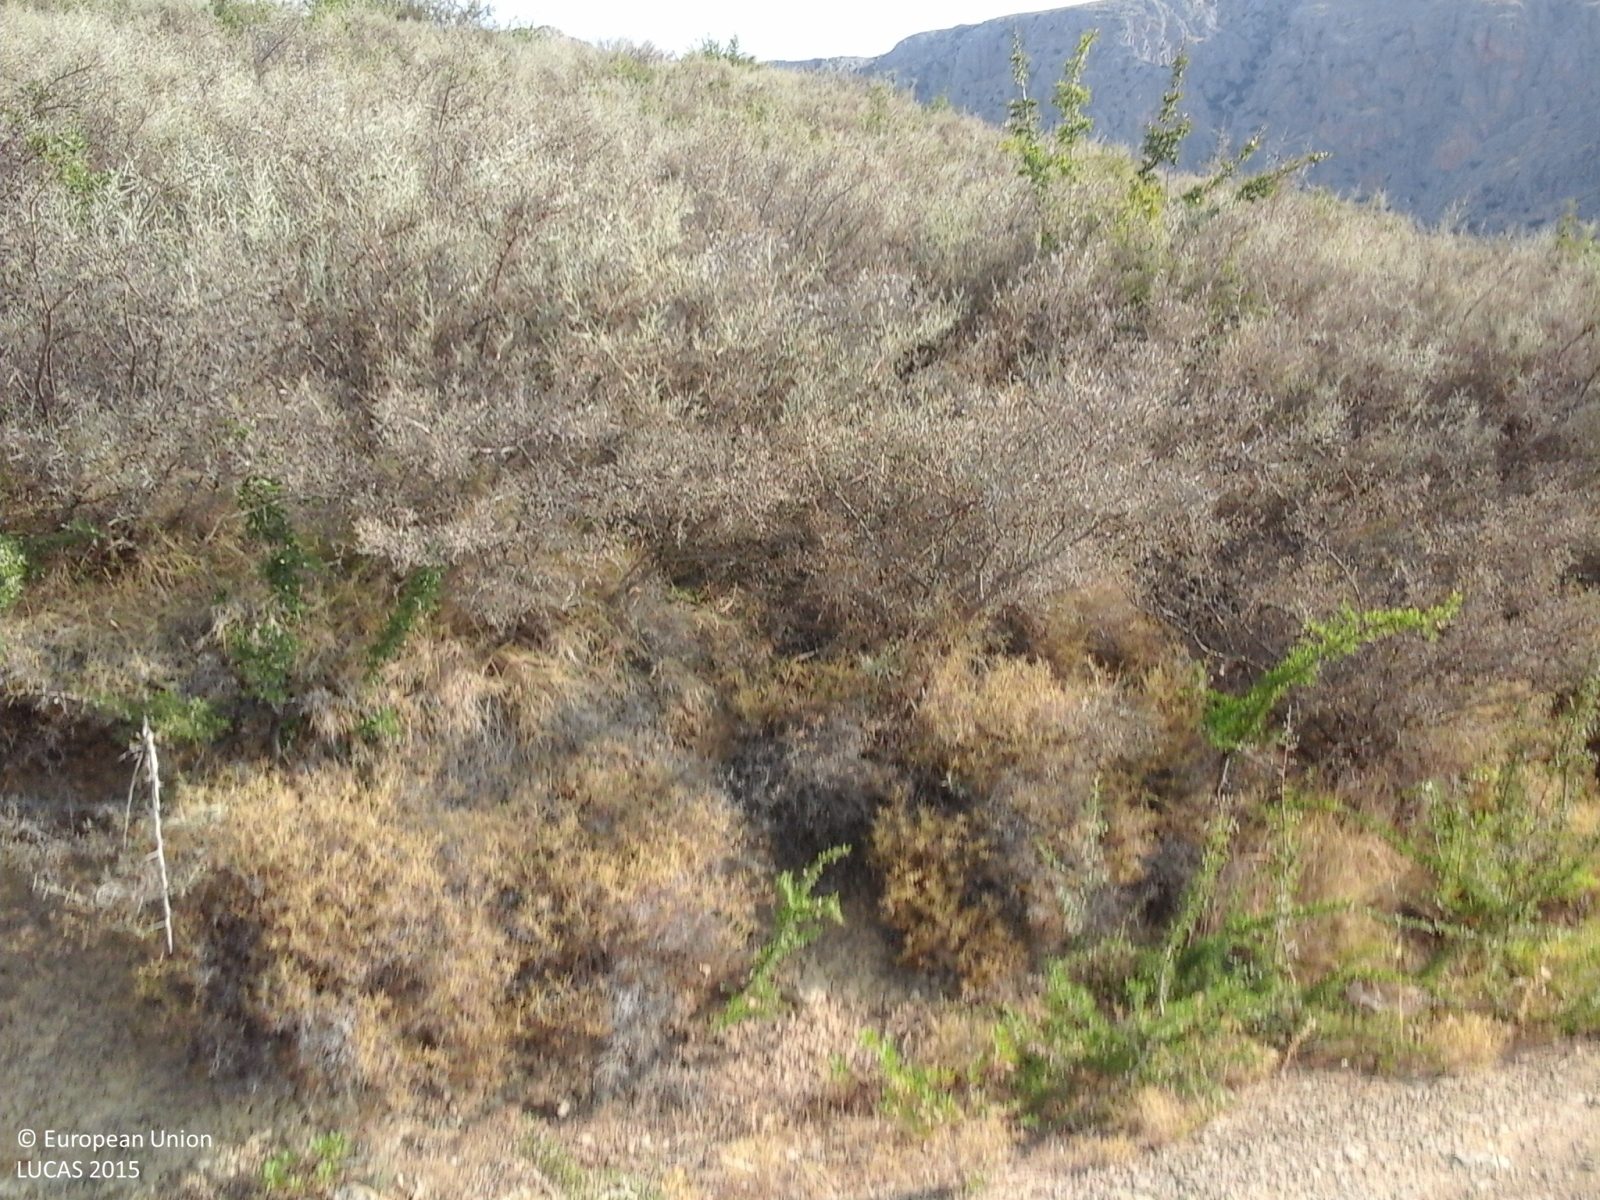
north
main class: Shrubland
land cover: Shrubland without tree cover
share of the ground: > 75 %
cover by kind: shrubs 90 %, herbaceous plants 10 %
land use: Semi-natural and natural areas not in use
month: August
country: GR
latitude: 38.3858
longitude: 22.2106
